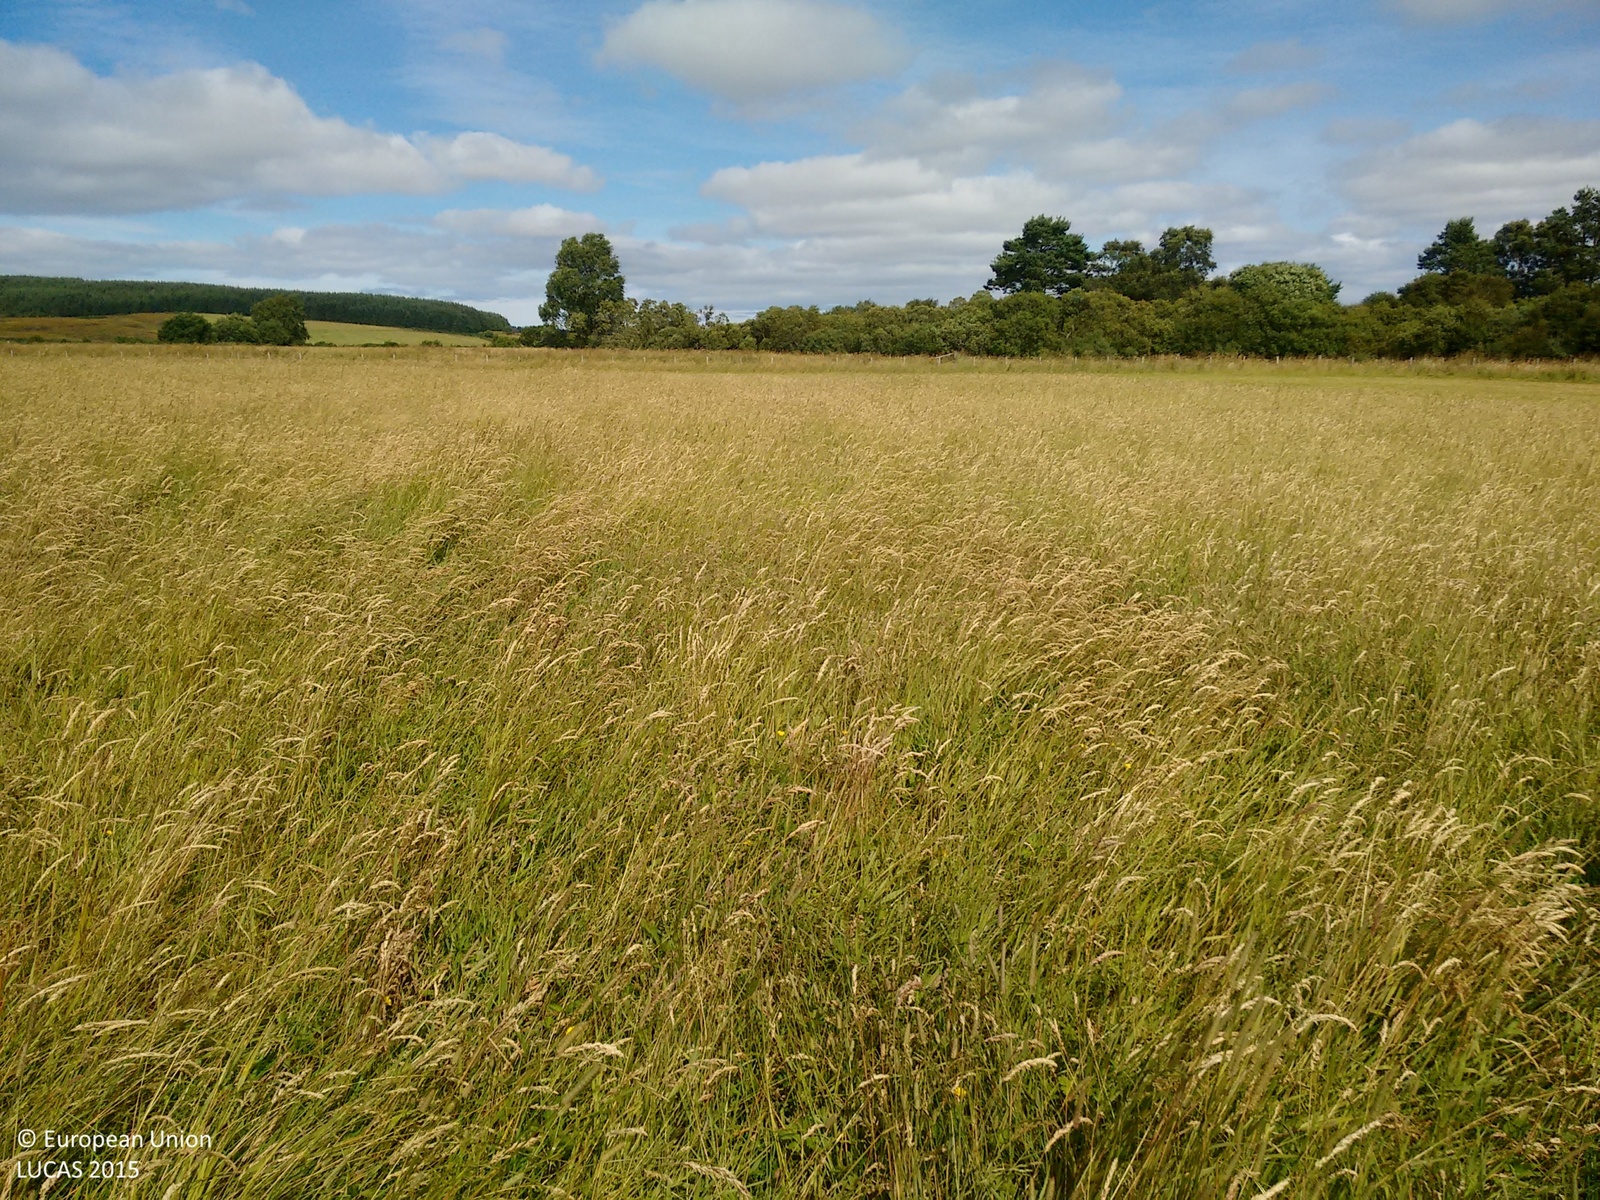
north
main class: Grassland
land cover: Grassland without tree/shrub cover
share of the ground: > 75 %
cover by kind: herbaceous plants 100 %
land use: Agriculture (excluding fallow land and kitchen gardens)
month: August
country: GB
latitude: 57.5744
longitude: -2.9180
